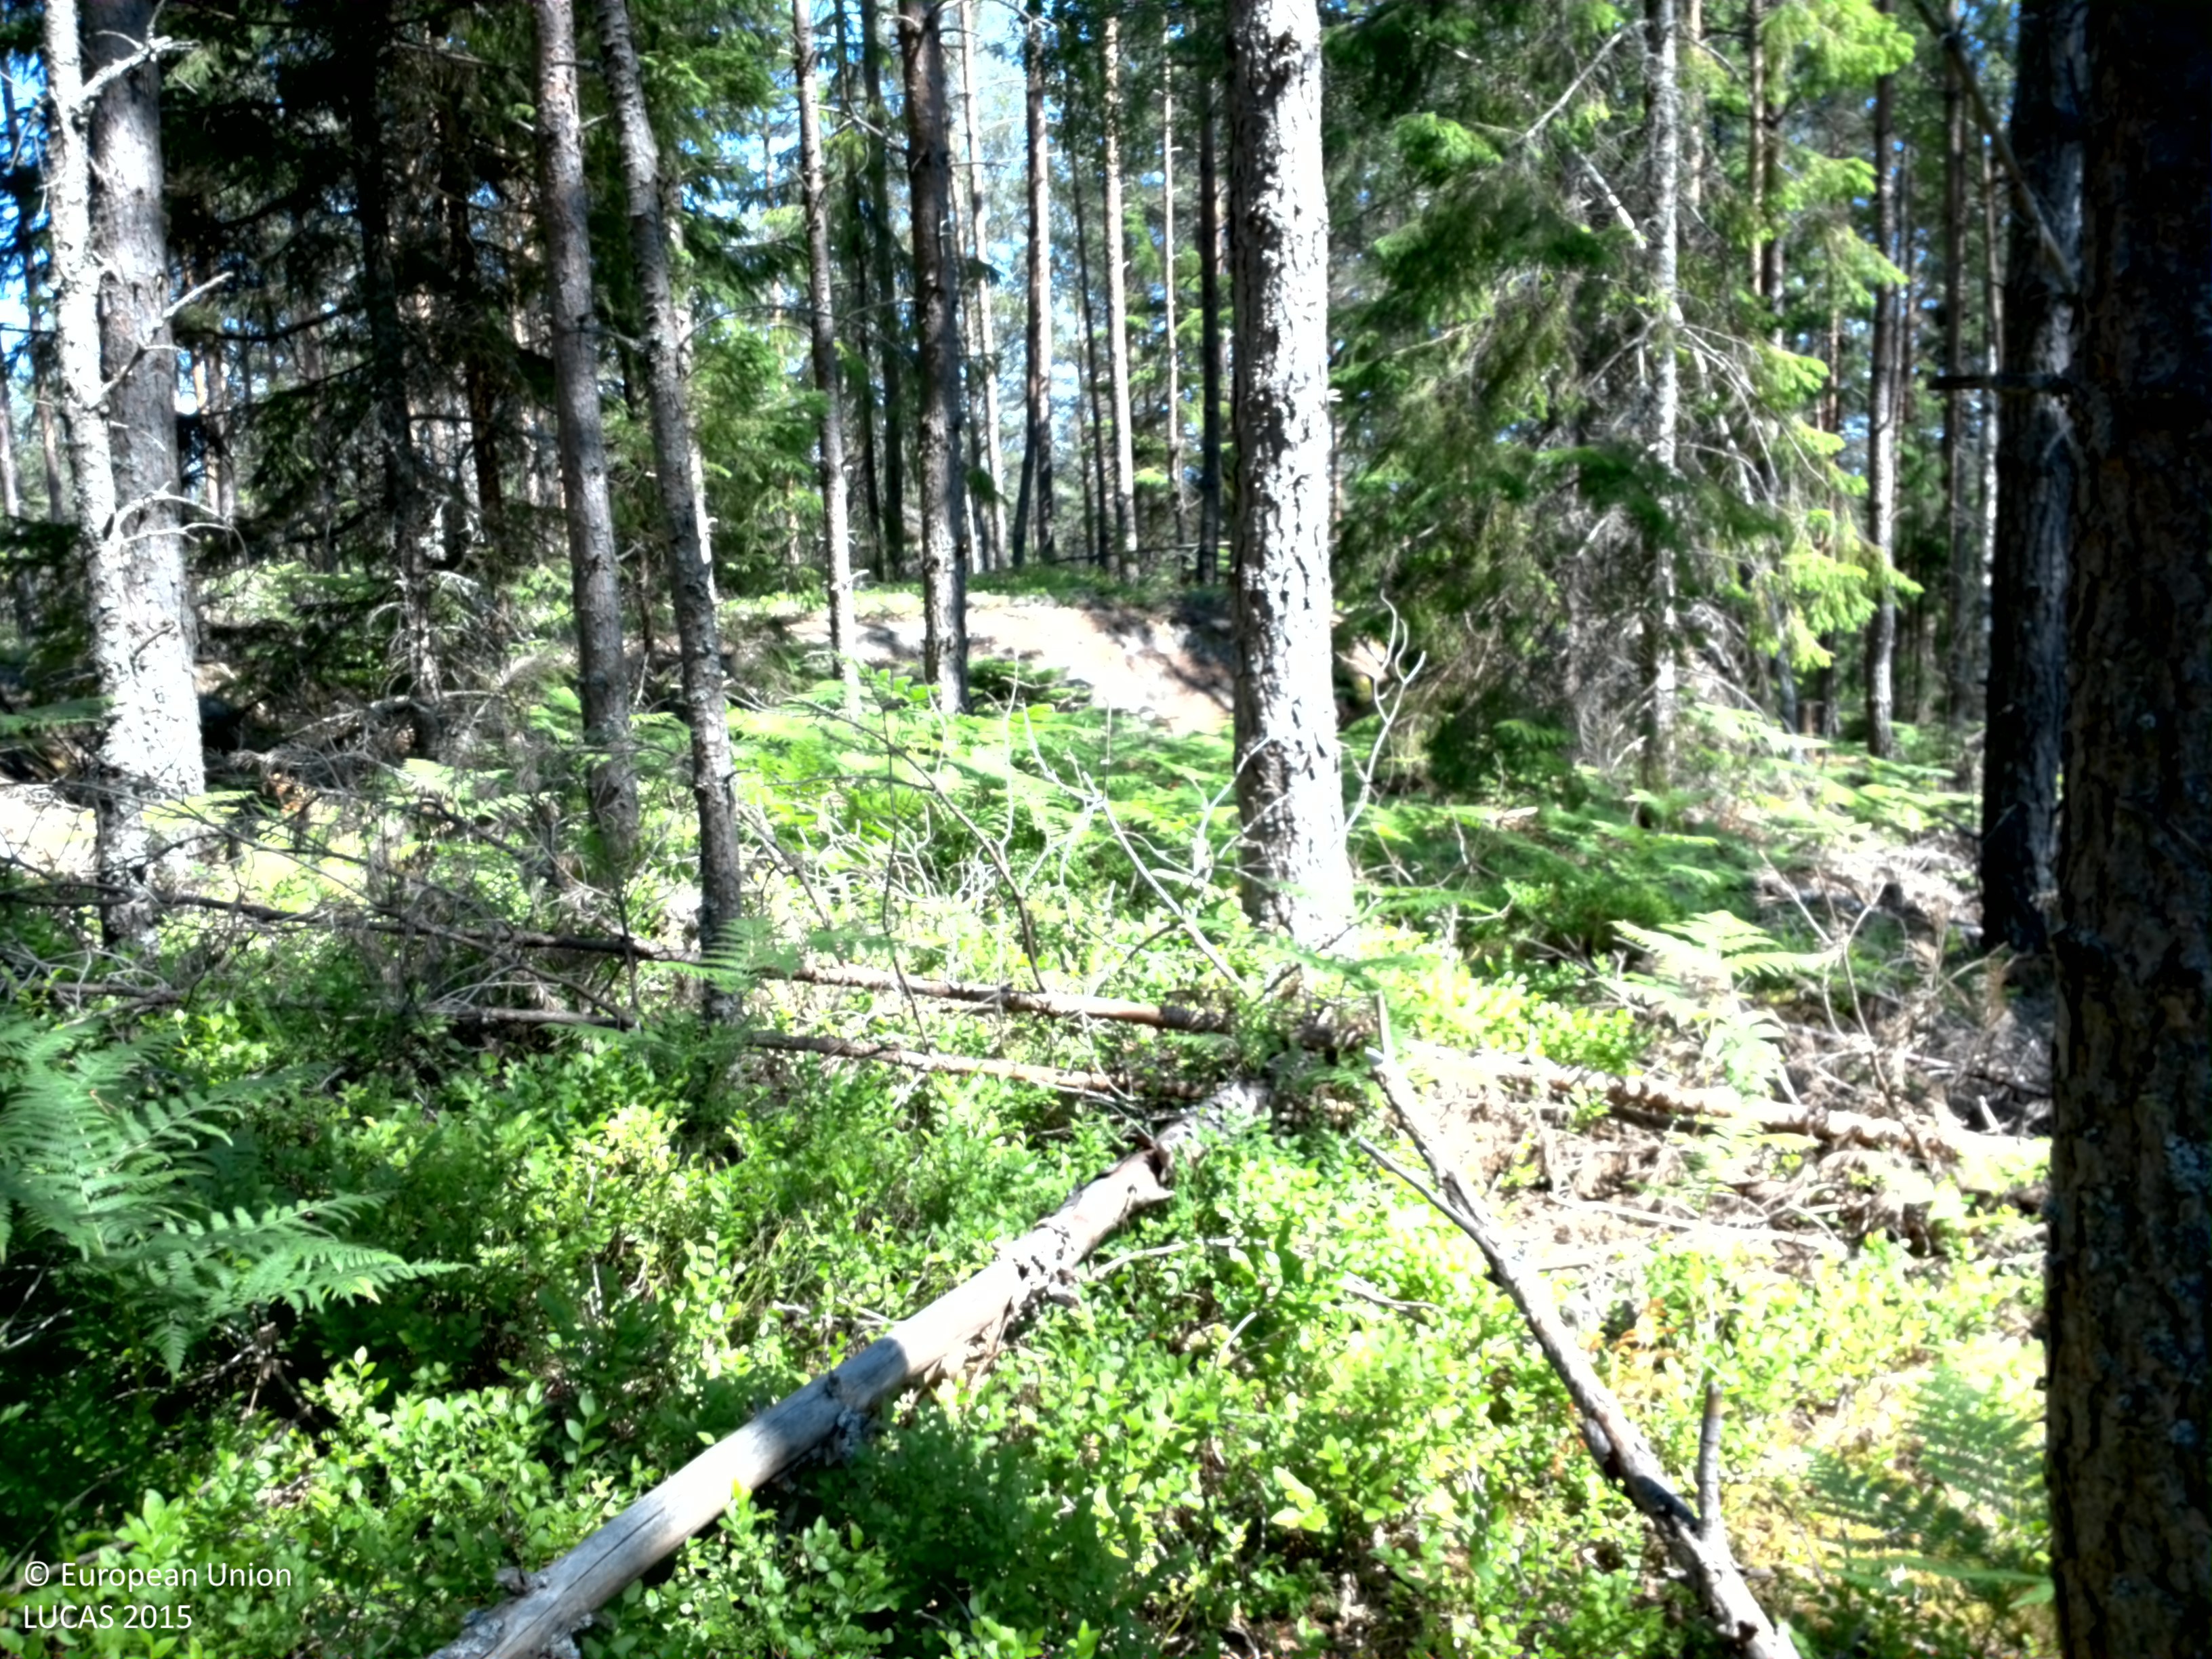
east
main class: Woodland
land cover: Pine dominated coniferous woodland
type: boreal forest
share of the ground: 10 - 25 %
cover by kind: herbaceous plants 70 %, coniferous forest trees 20 %, lichens and mosses 10 %
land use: Forestry
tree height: > 5 m
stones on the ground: < 10 %
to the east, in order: Pine dominated coniferous woodland; Rivers and streams; Pine dominated coniferous woodland; Other coniferous woodland
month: July
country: SE
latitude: 58.7353
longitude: 14.6054
